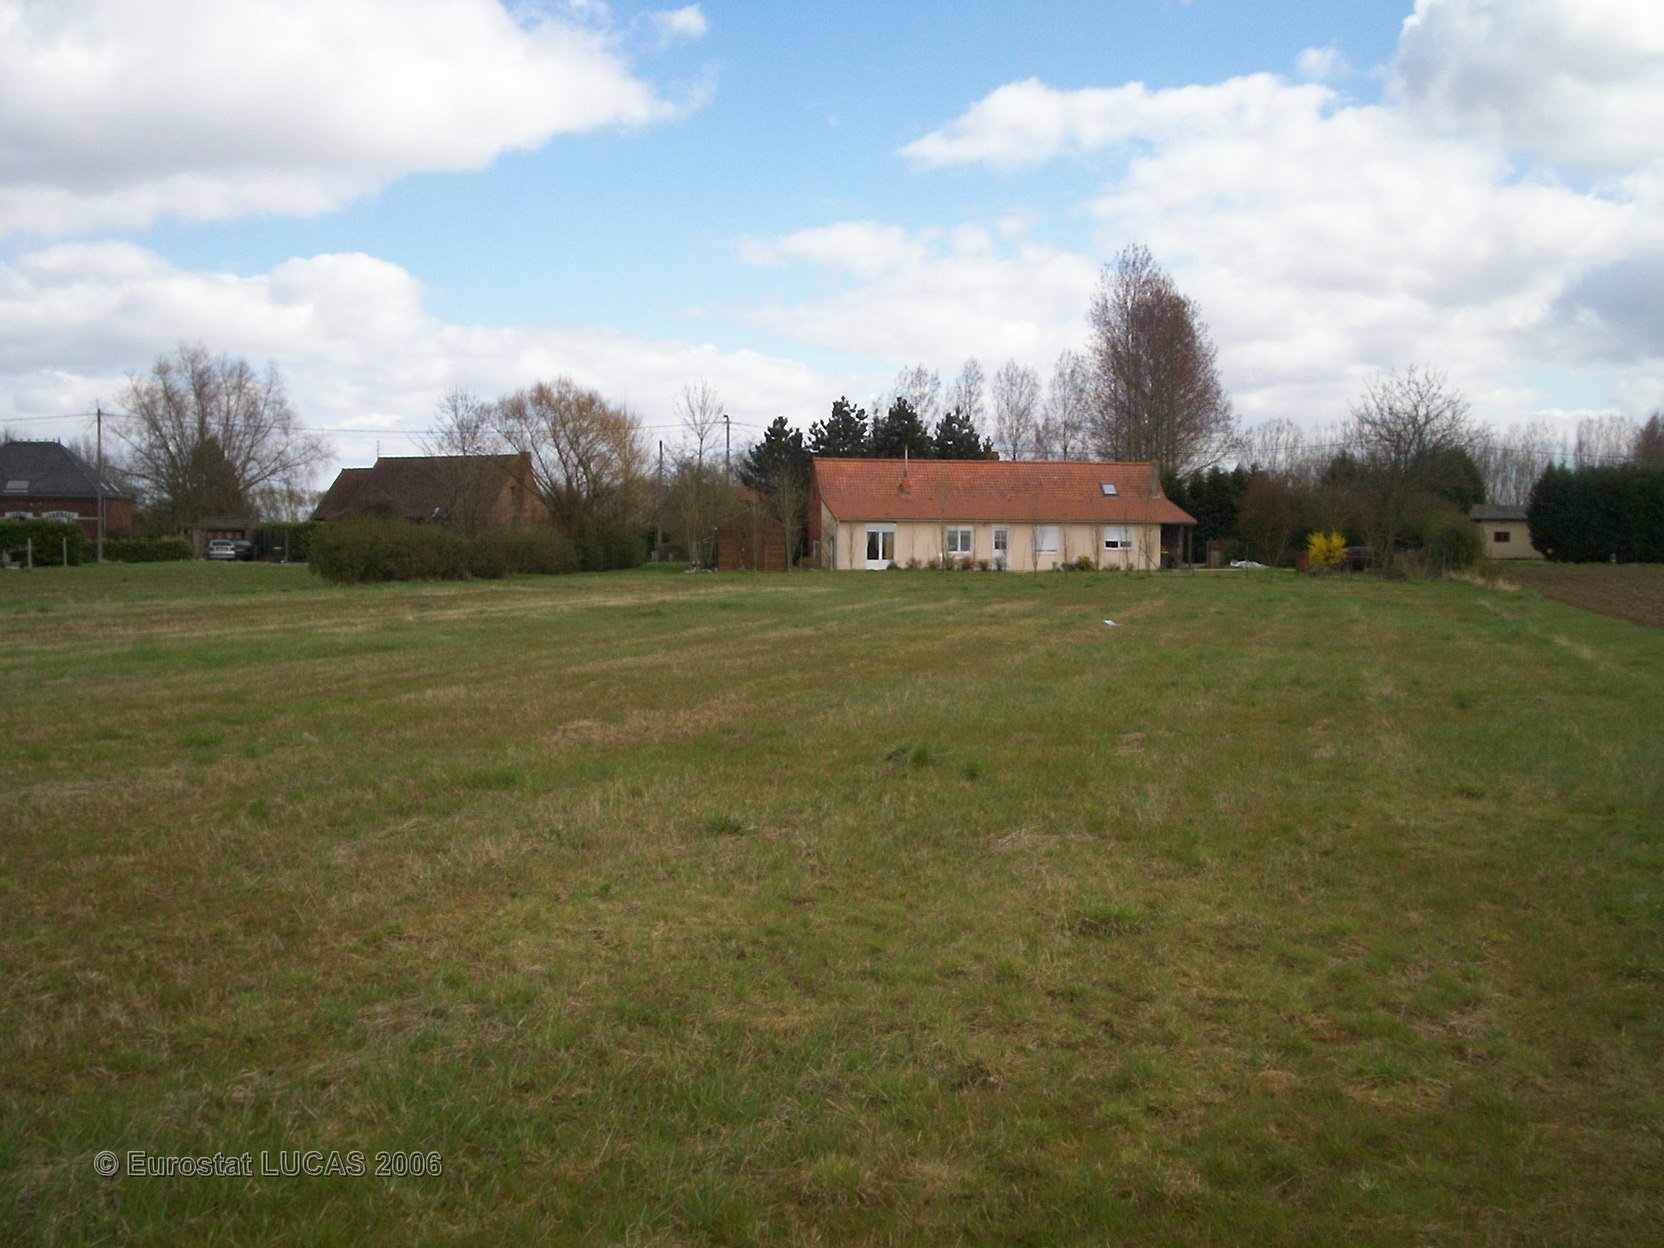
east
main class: Grassland
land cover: Grassland without tree/shrub cover
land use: Agriculture (excluding fallow land and kitchen gardens)
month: April
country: FR
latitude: 50.6116
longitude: 2.5970
